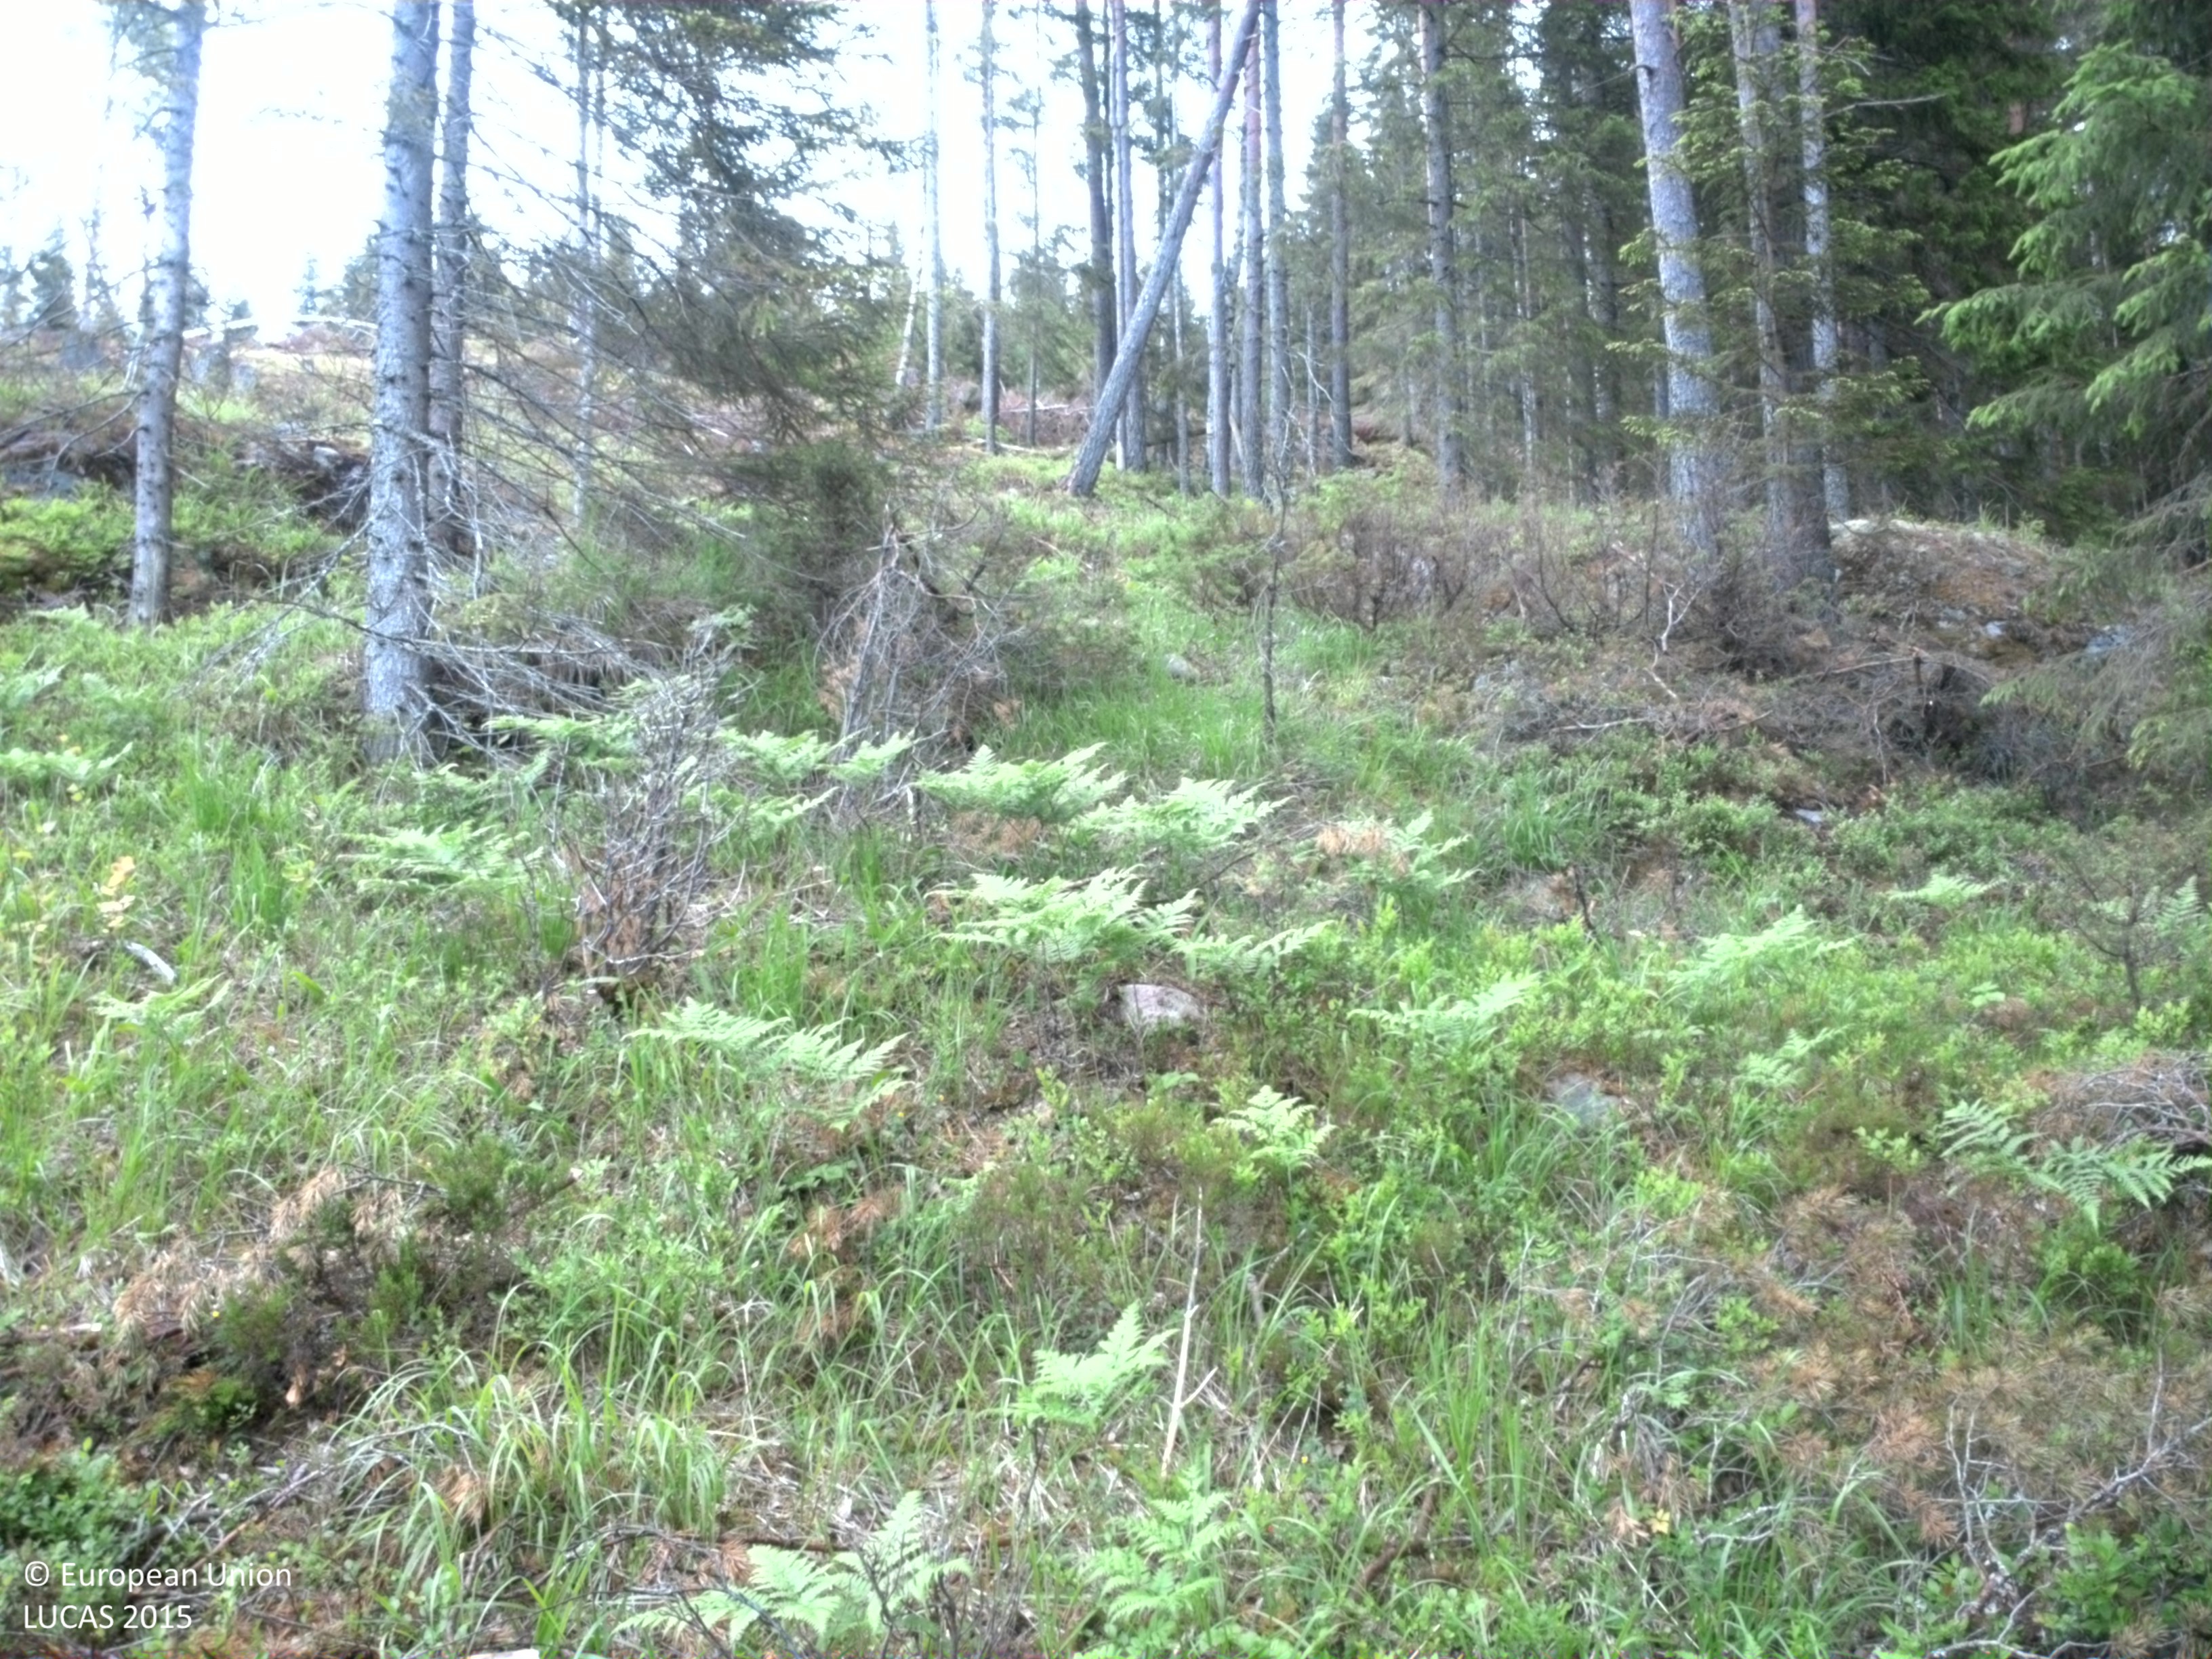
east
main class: Shrubland
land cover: Shrubland with sparse tree cover
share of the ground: 50 - 75 %
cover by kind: shrubs 70 %, lichens and mosses 10 %, consolidated bare surface 10 %, coniferous forest trees 5 %, herbaceous plants 5 %
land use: Forestry
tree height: < 5 m
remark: Clear cut
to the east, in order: Shrubland with sparse tree cover; Pine dominated coniferous woodland; Spruce dominated coniferous woodland
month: June
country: SE
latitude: 59.7512
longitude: 12.0764
